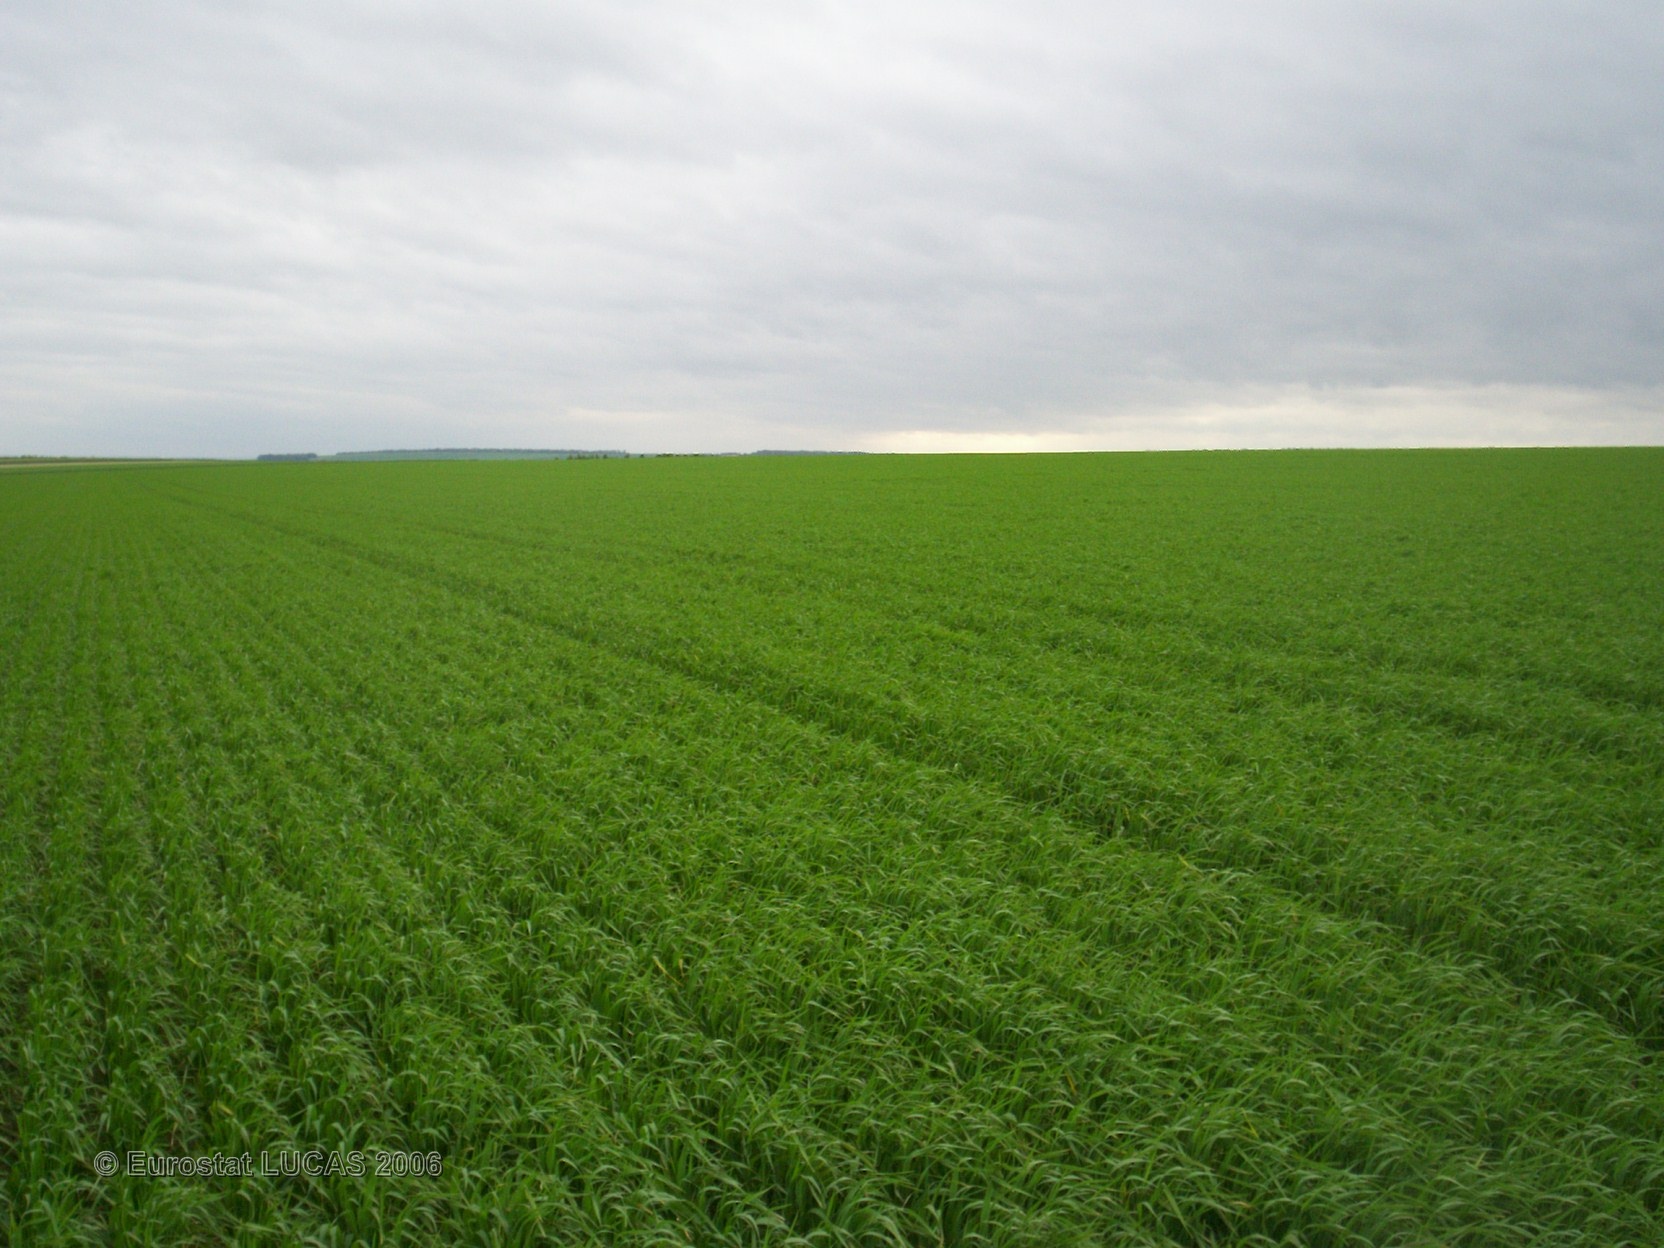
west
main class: Cropland
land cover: Barley
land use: Agriculture (excluding fallow land and kitchen gardens)
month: May
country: FR
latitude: 49.3598
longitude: 4.3646
